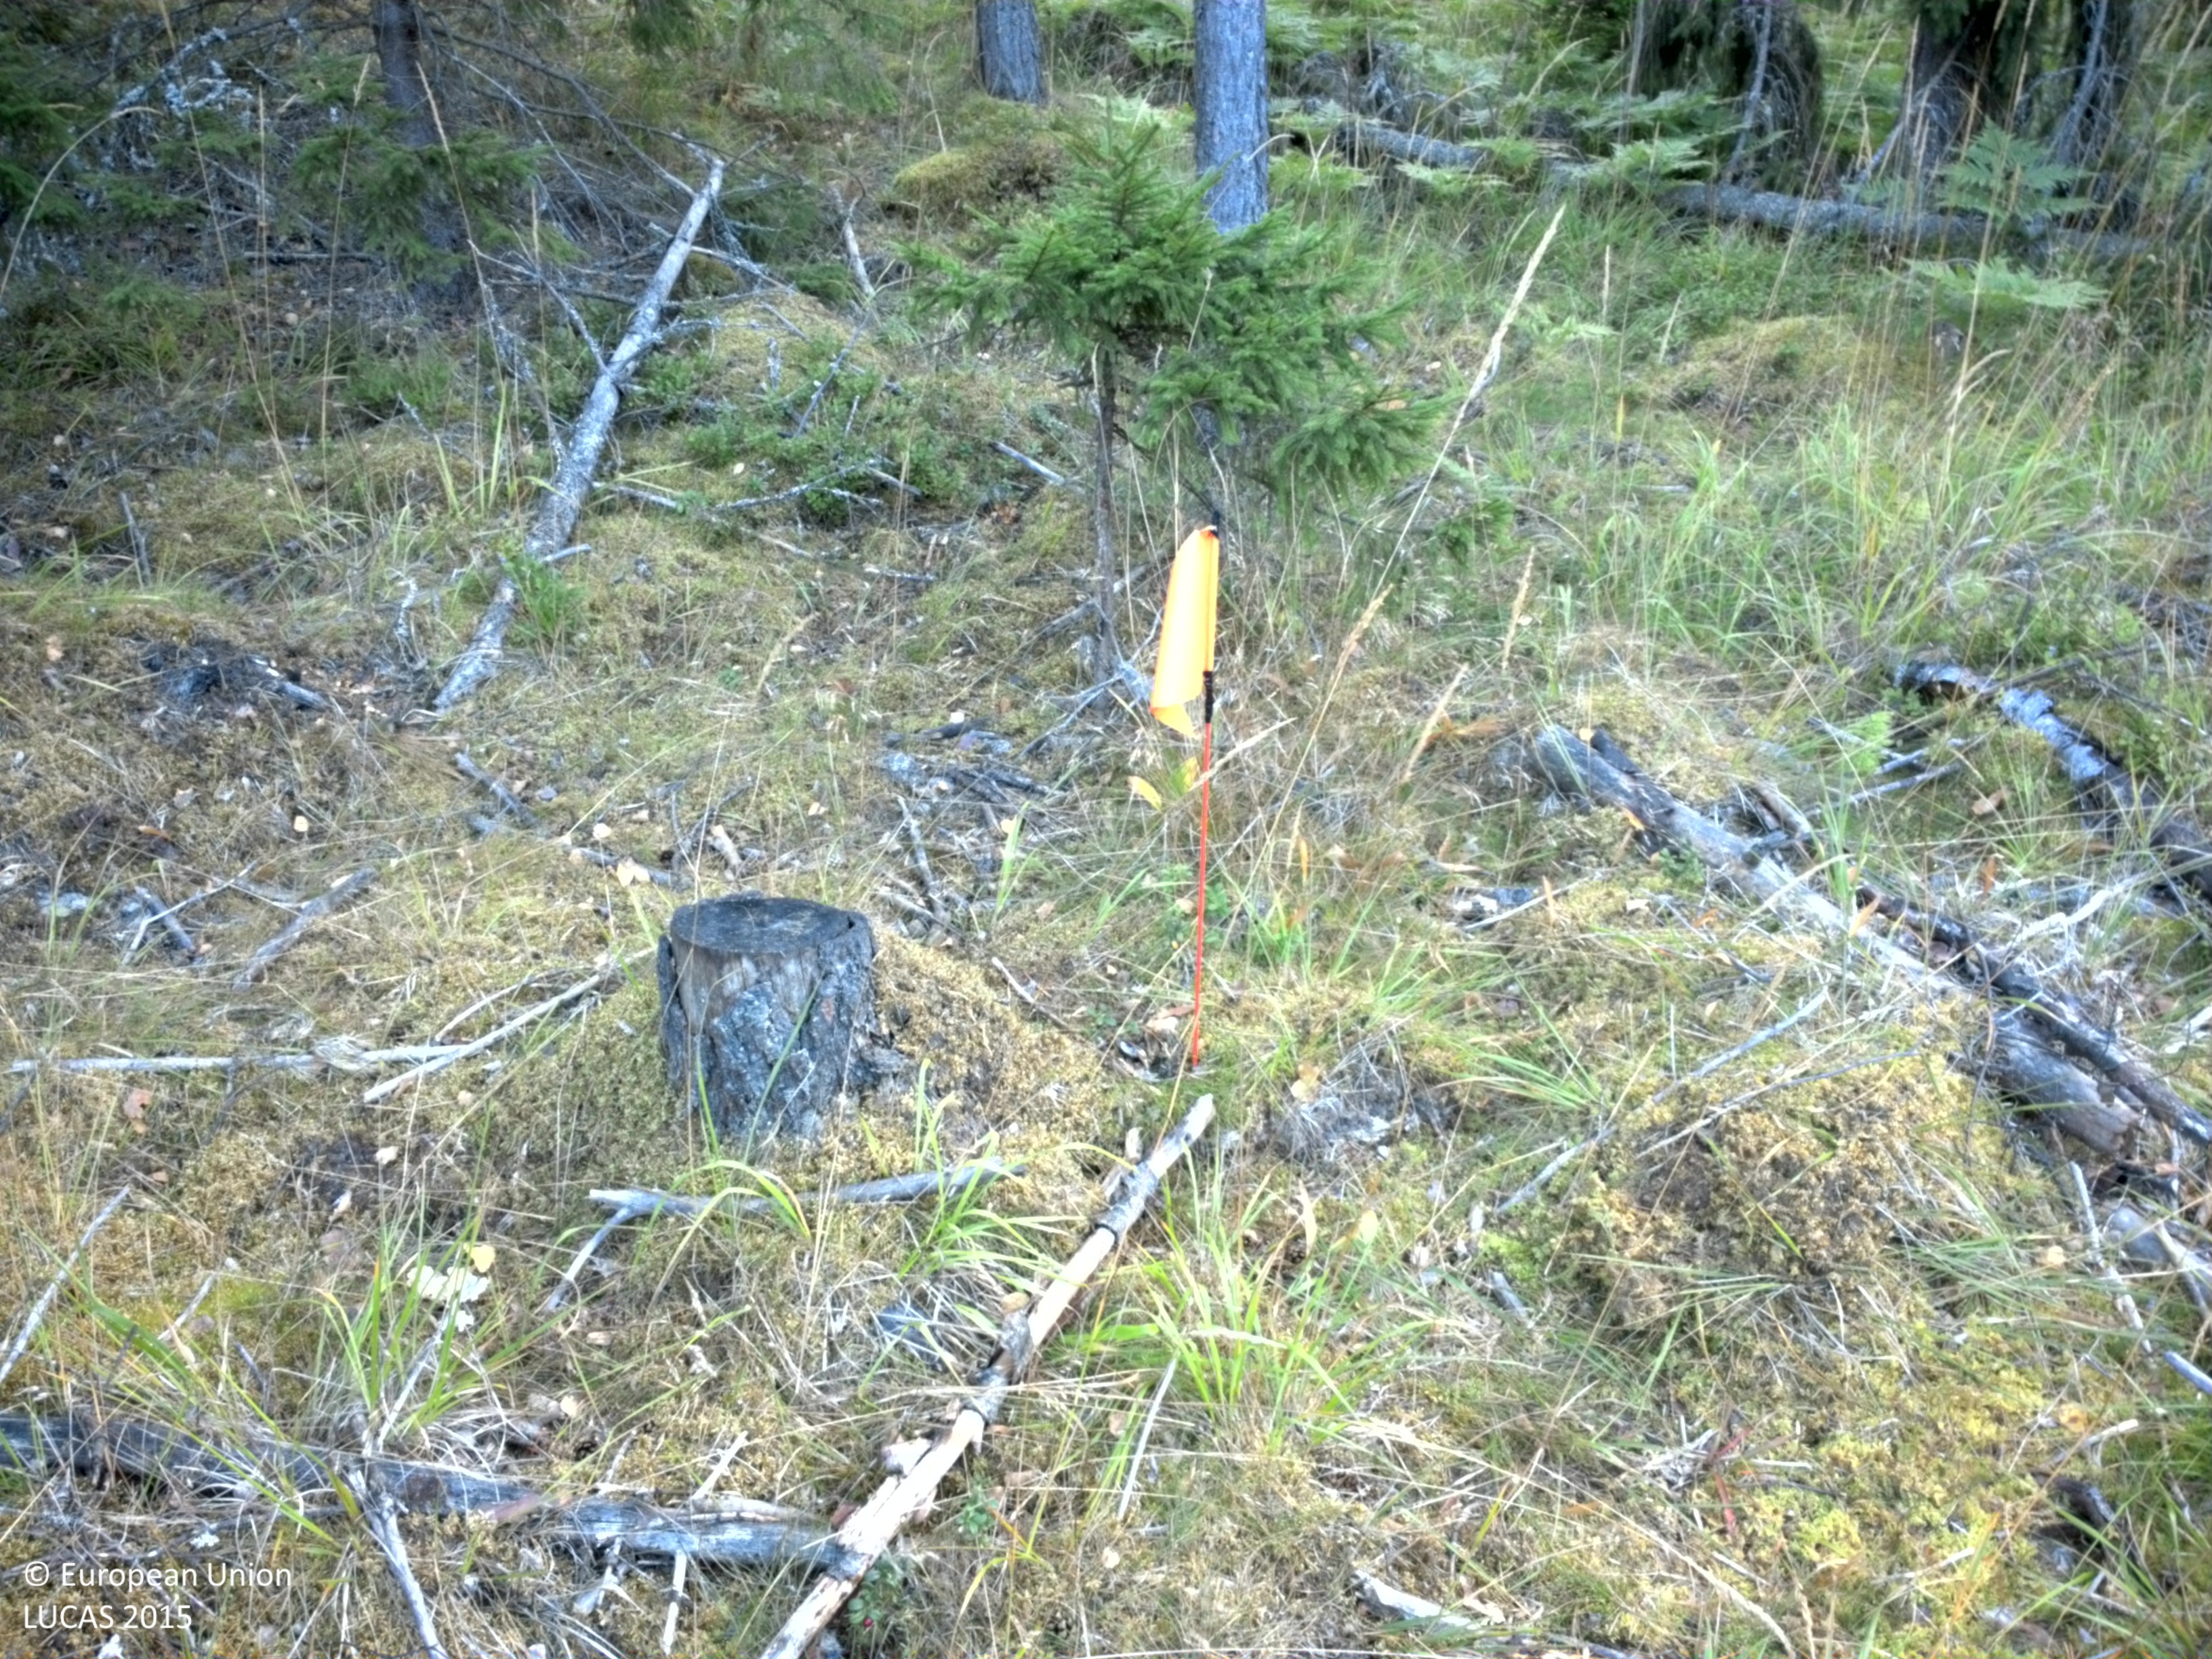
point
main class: Woodland
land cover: Pine dominated coniferous woodland
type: boreal forest
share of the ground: 50 - 75 %
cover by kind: coniferous forest trees 65 %, herbaceous plants 15 %, lichens and mosses 15 %, broadleaved forest trees 5 %
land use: Forestry
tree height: > 5 m
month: August
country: SE
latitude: 59.5781
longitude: 17.5910
